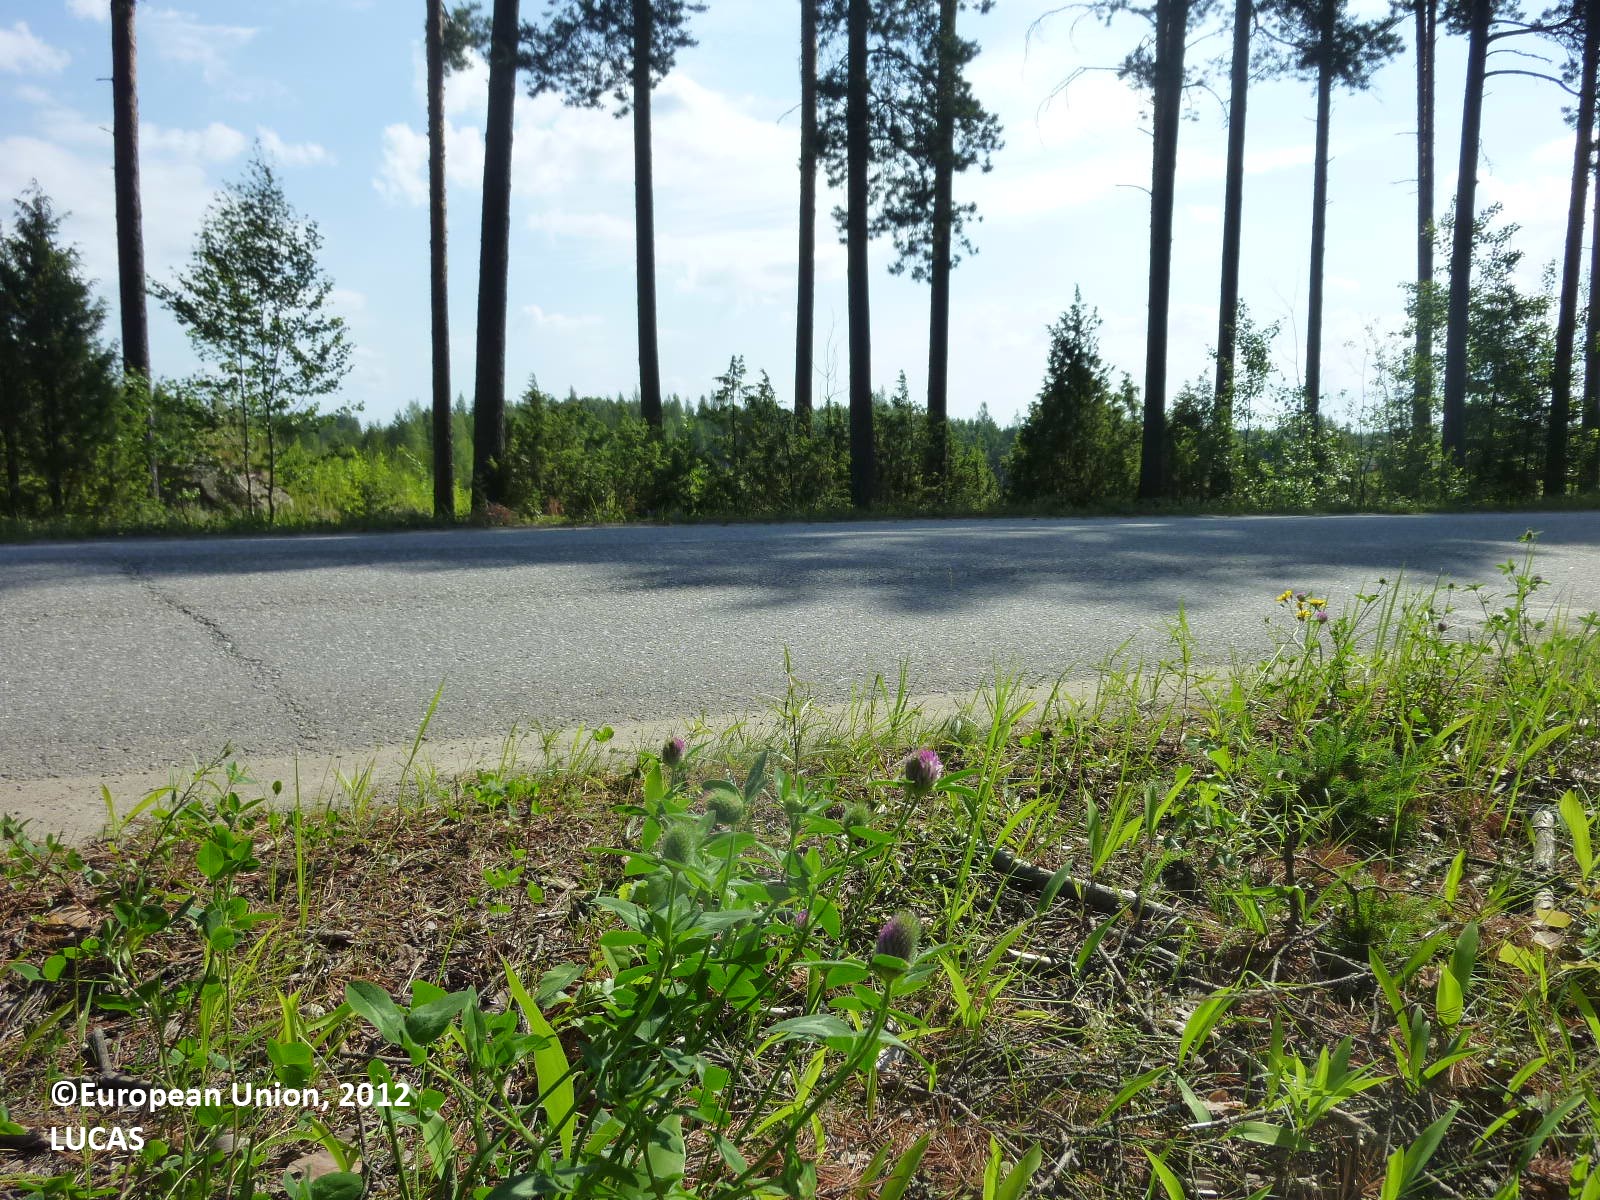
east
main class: Grassland
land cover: Grassland without tree/shrub cover
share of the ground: > 75 %
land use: Road transport
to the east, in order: Grassland without tree/shrub cover; Paved roads, cycling and walking lanes; Grass margins; Pine dominated coniferous woodland; Grassland with sparse tree/shrub cover; Sand; Grassland with sparse tree/shrub cover; Rocks and stones
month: July
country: FI
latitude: 61.2545
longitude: 22.4225
